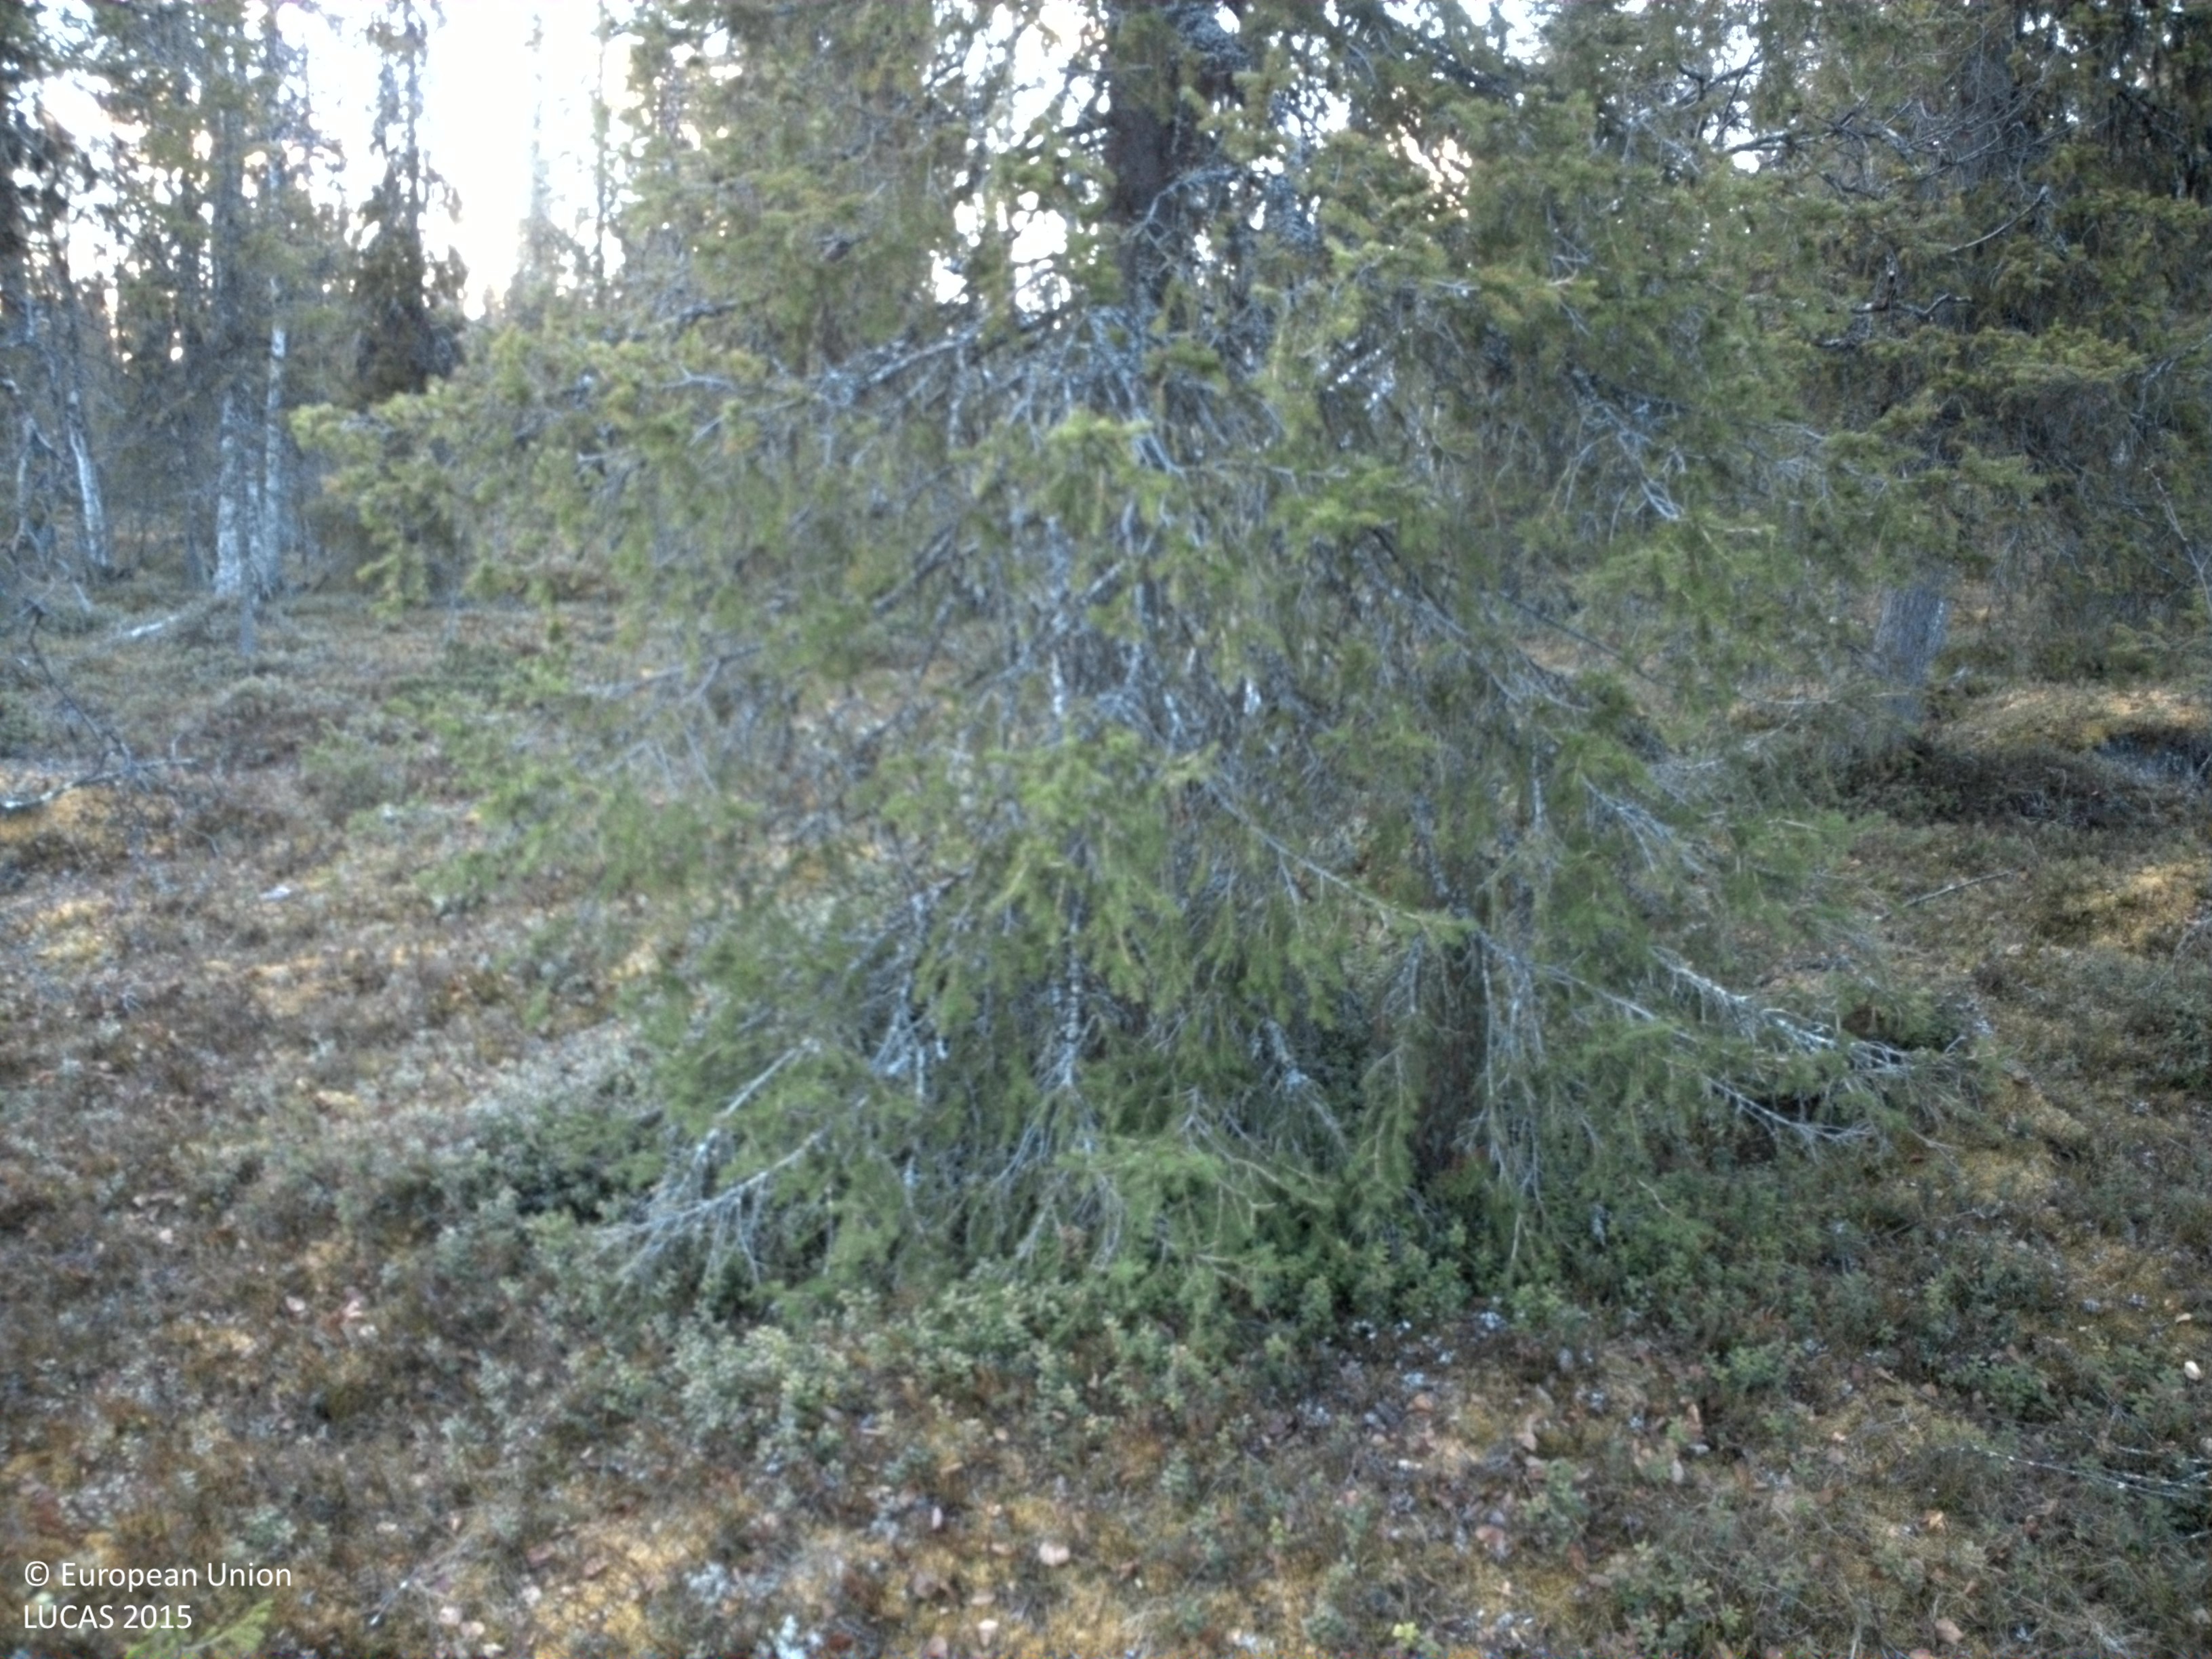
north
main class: Woodland
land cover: Spruce dominated mixed woodland
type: boreal forest
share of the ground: 25 - 50 %
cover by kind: herbaceous plants 55 %, coniferous forest trees 15 %, lichens and mosses 15 %, broadleaved forest trees 10 %, shrubs 5 %
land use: Forestry
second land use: Amenities, museums, leisure
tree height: > 5 m
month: June
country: SE
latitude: 67.3055
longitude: 20.1417
